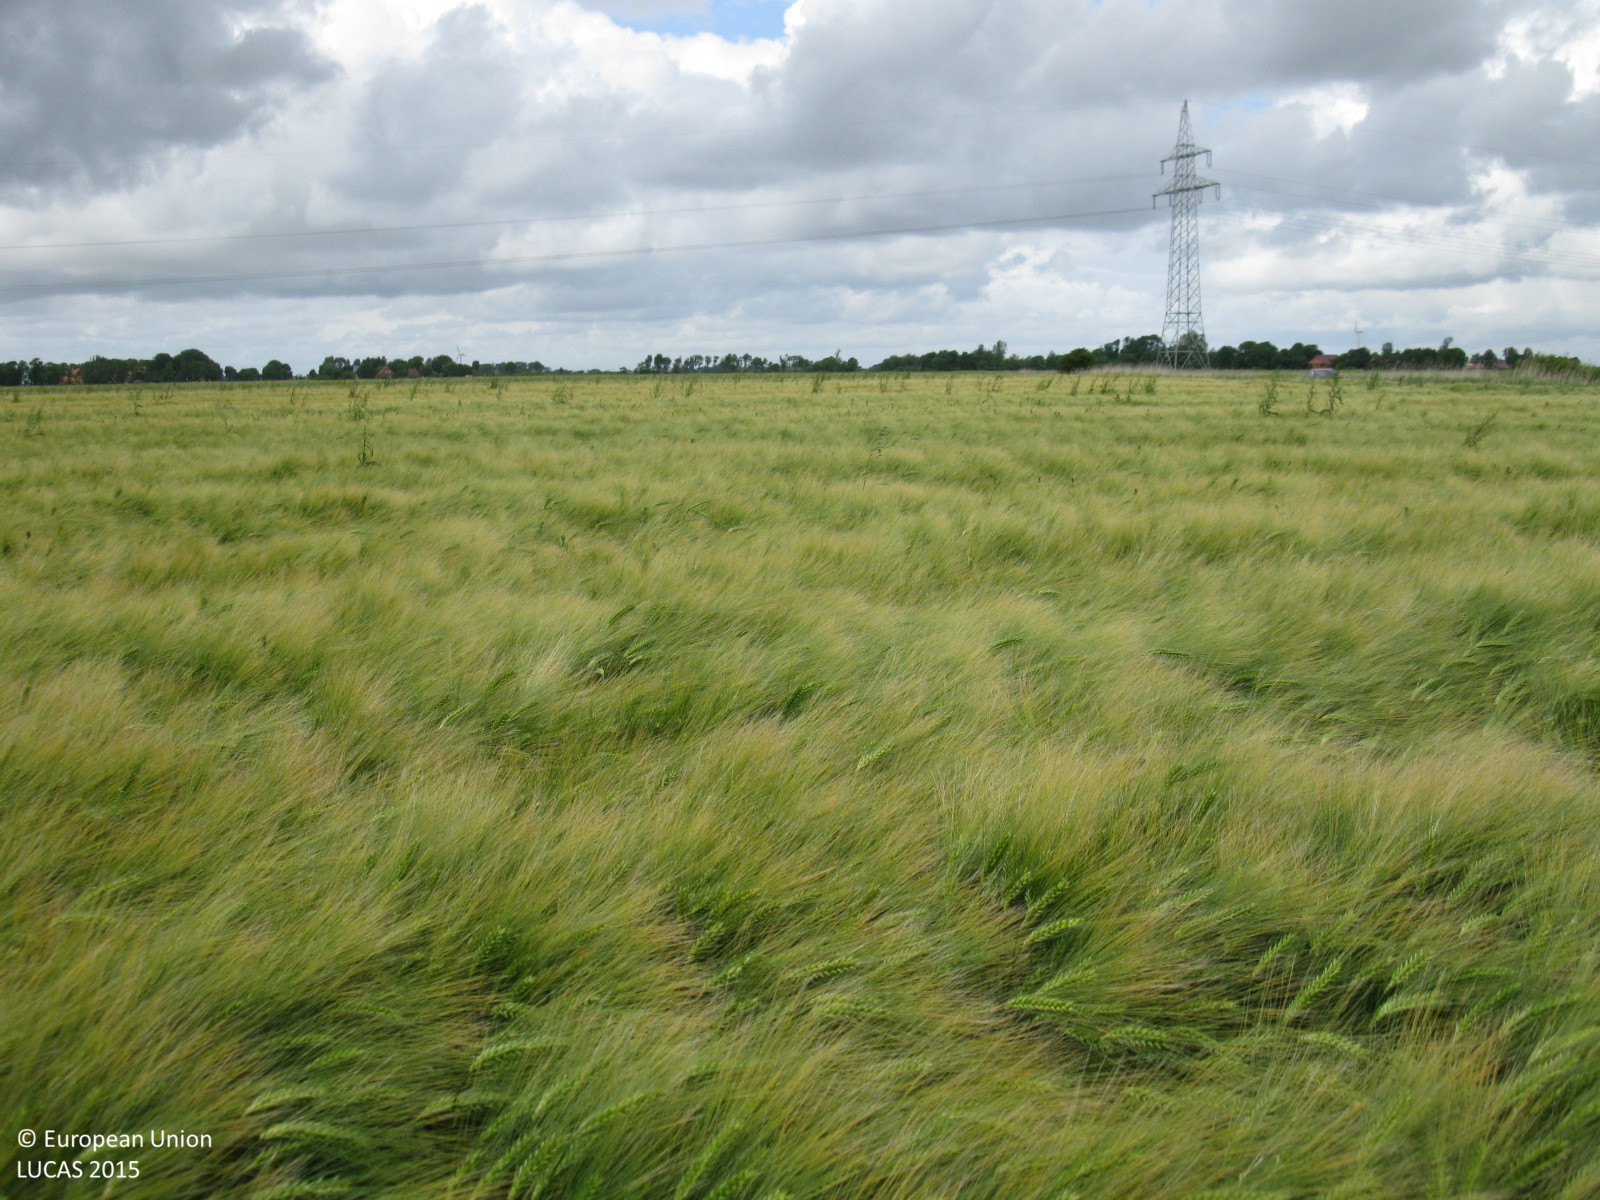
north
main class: Cropland
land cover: Barley
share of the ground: > 75 %
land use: Agriculture (excluding fallow land and kitchen gardens)
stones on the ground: < 10 %
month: June
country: DE
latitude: 53.6428
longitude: 7.3536
